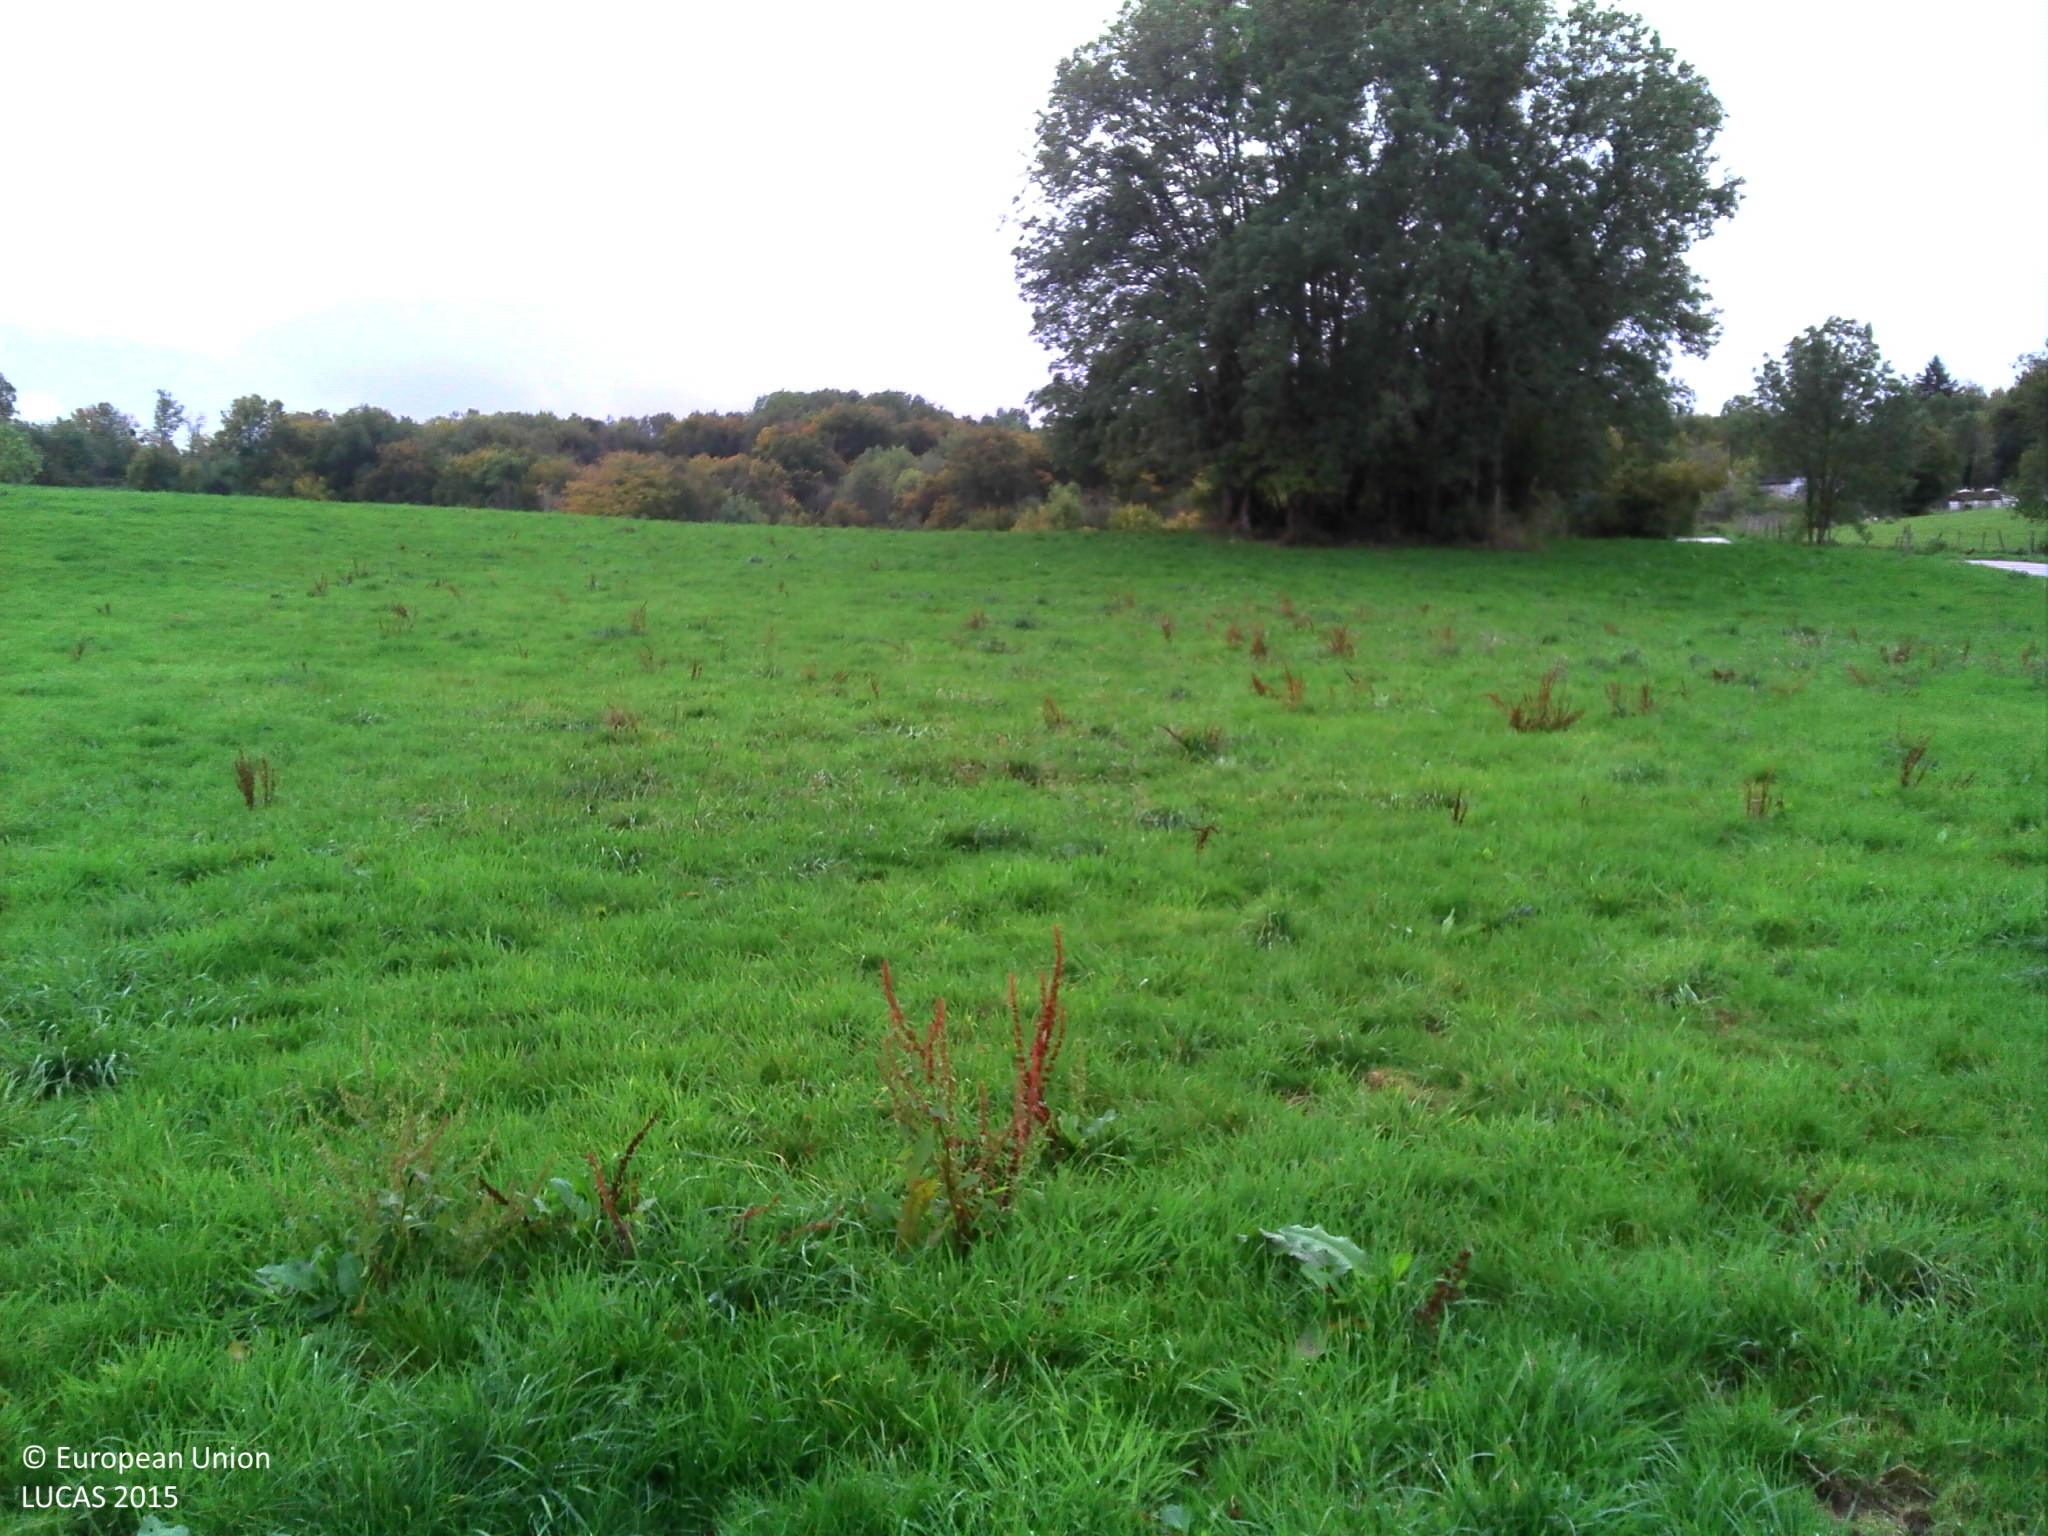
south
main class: Grassland
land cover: Grassland without tree/shrub cover
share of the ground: > 75 %
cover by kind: herbaceous plants 100 %
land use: Agriculture (excluding fallow land and kitchen gardens)
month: October
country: FR
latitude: 47.0201
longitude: 6.1211
